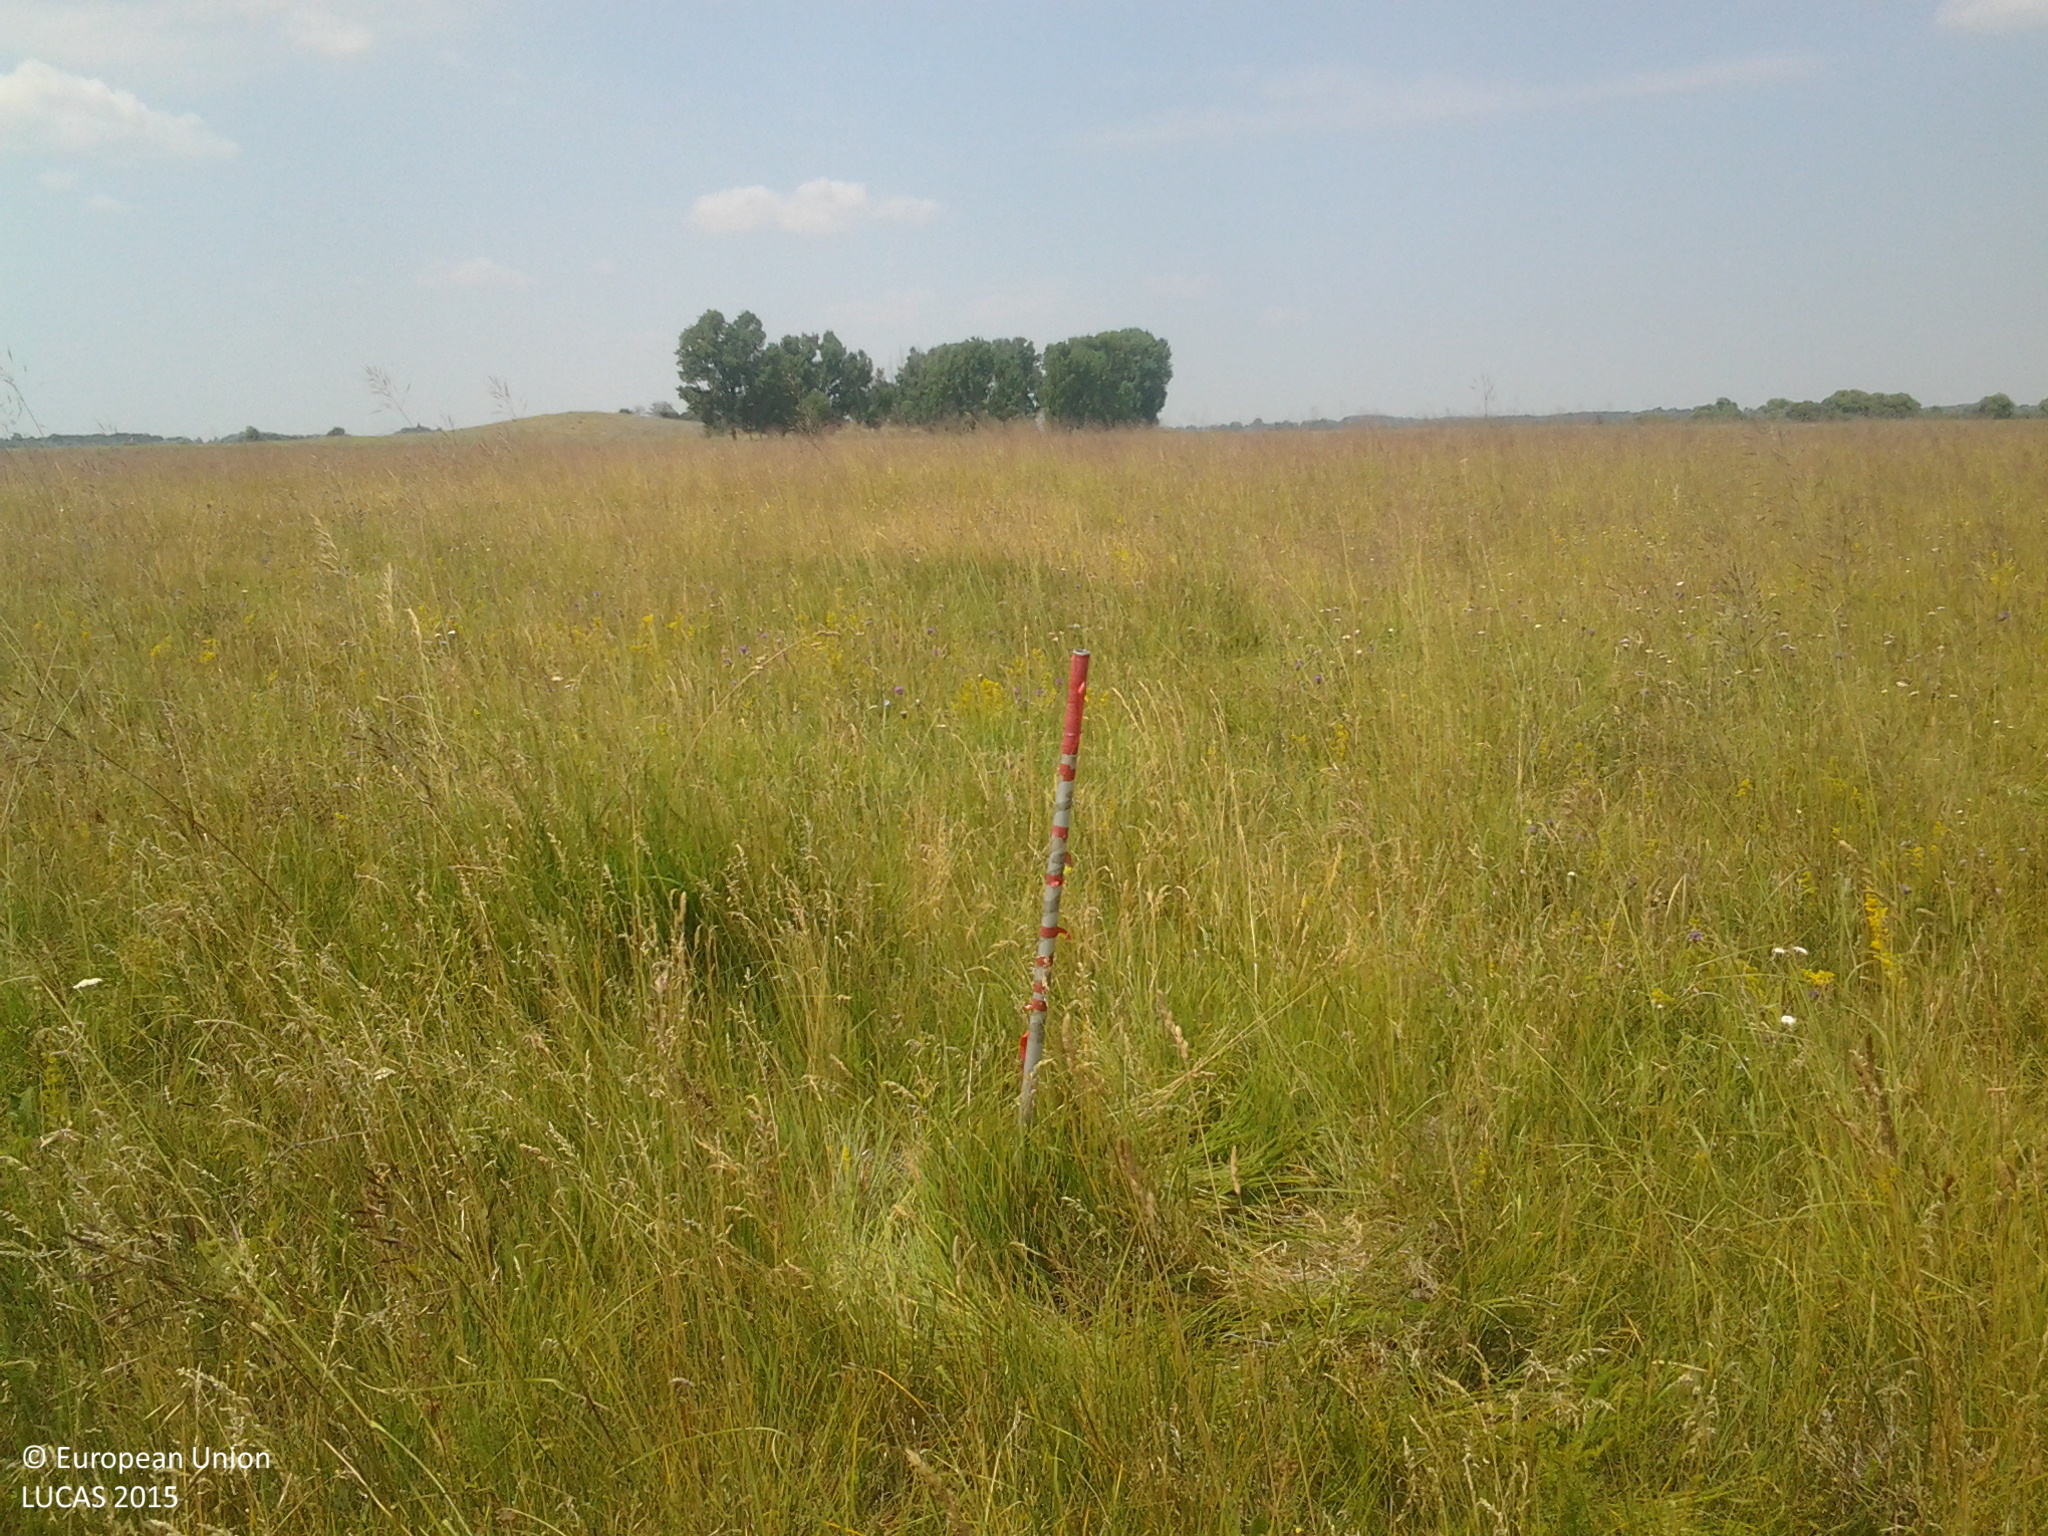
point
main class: Grassland
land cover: Grassland without tree/shrub cover
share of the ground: > 75 %
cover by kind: herbaceous plants 100 %
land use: Semi-natural and natural areas not in use
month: July
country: HU
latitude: 47.1089
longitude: 19.2556
